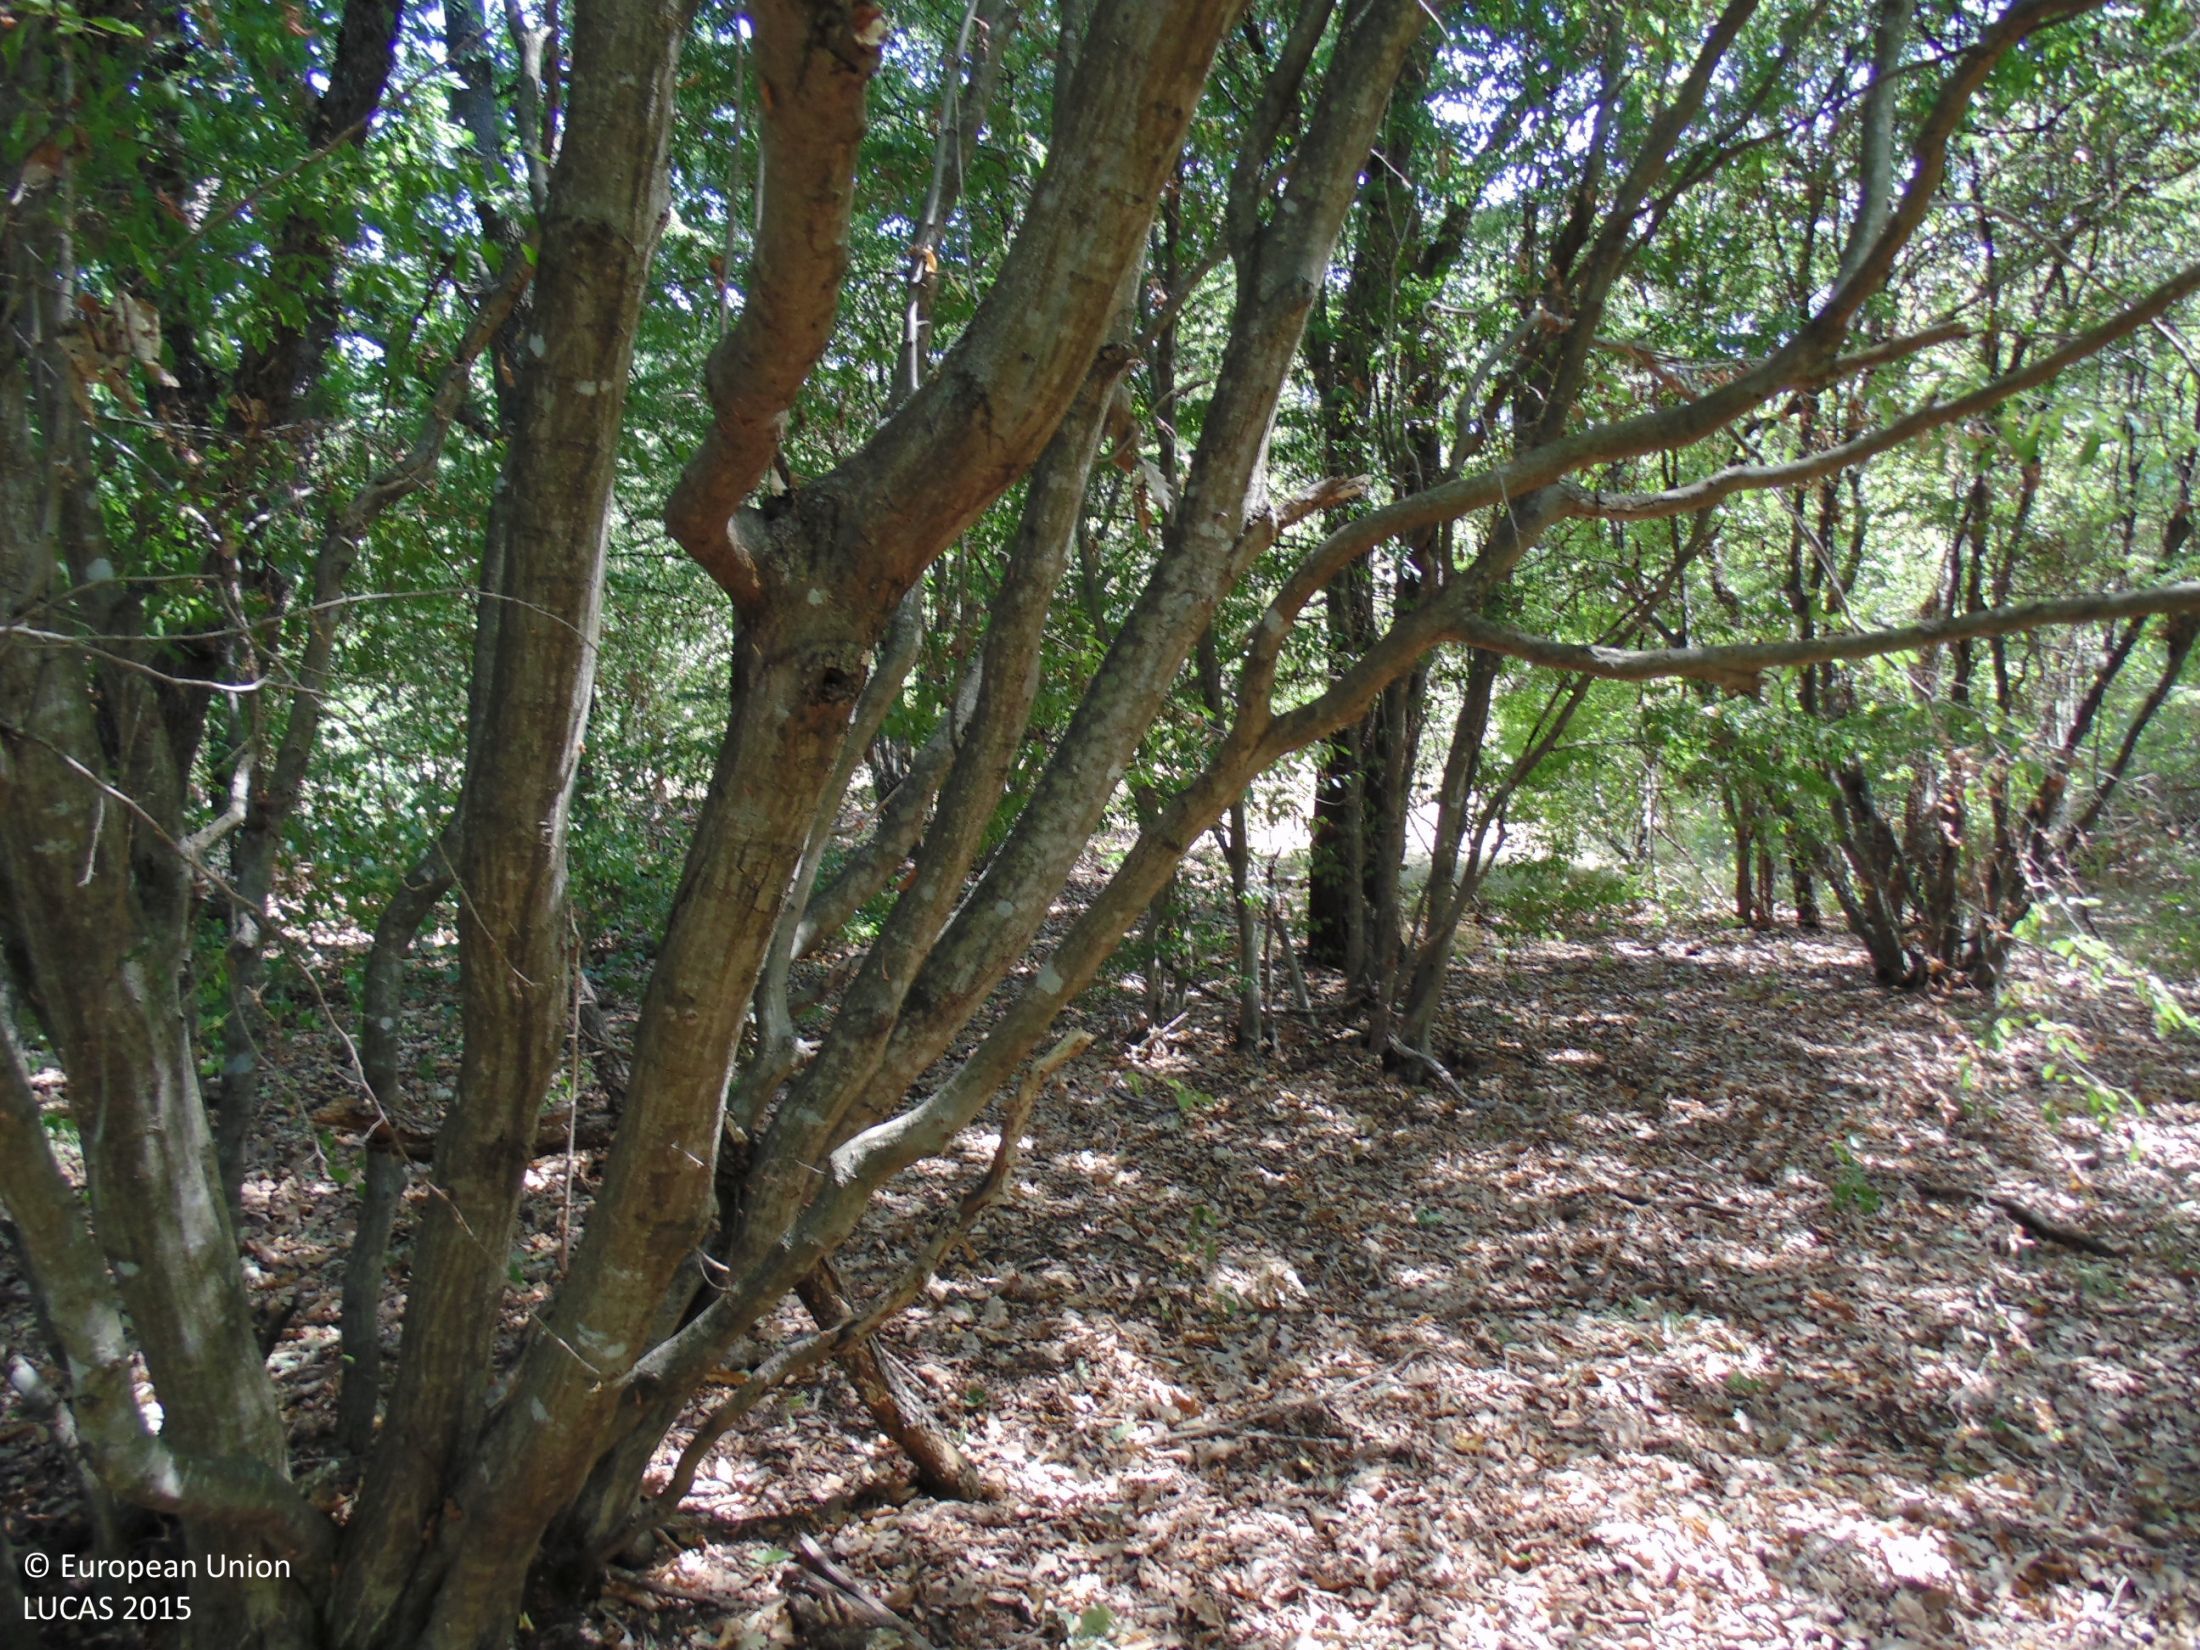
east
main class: Woodland
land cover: Broadleaved woodland
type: mesophytic deciduous forest
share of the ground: > 75 %
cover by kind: broadleaved forest trees 90 %, shrubs 5 %, unconsolidated bare surface 5 %
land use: Forestry
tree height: > 5 m
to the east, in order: Broadleaved woodland; Grassland with sparse tree/shrub cover; Broadleaved woodland
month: August
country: BG
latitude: 43.7204
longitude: 27.5758
